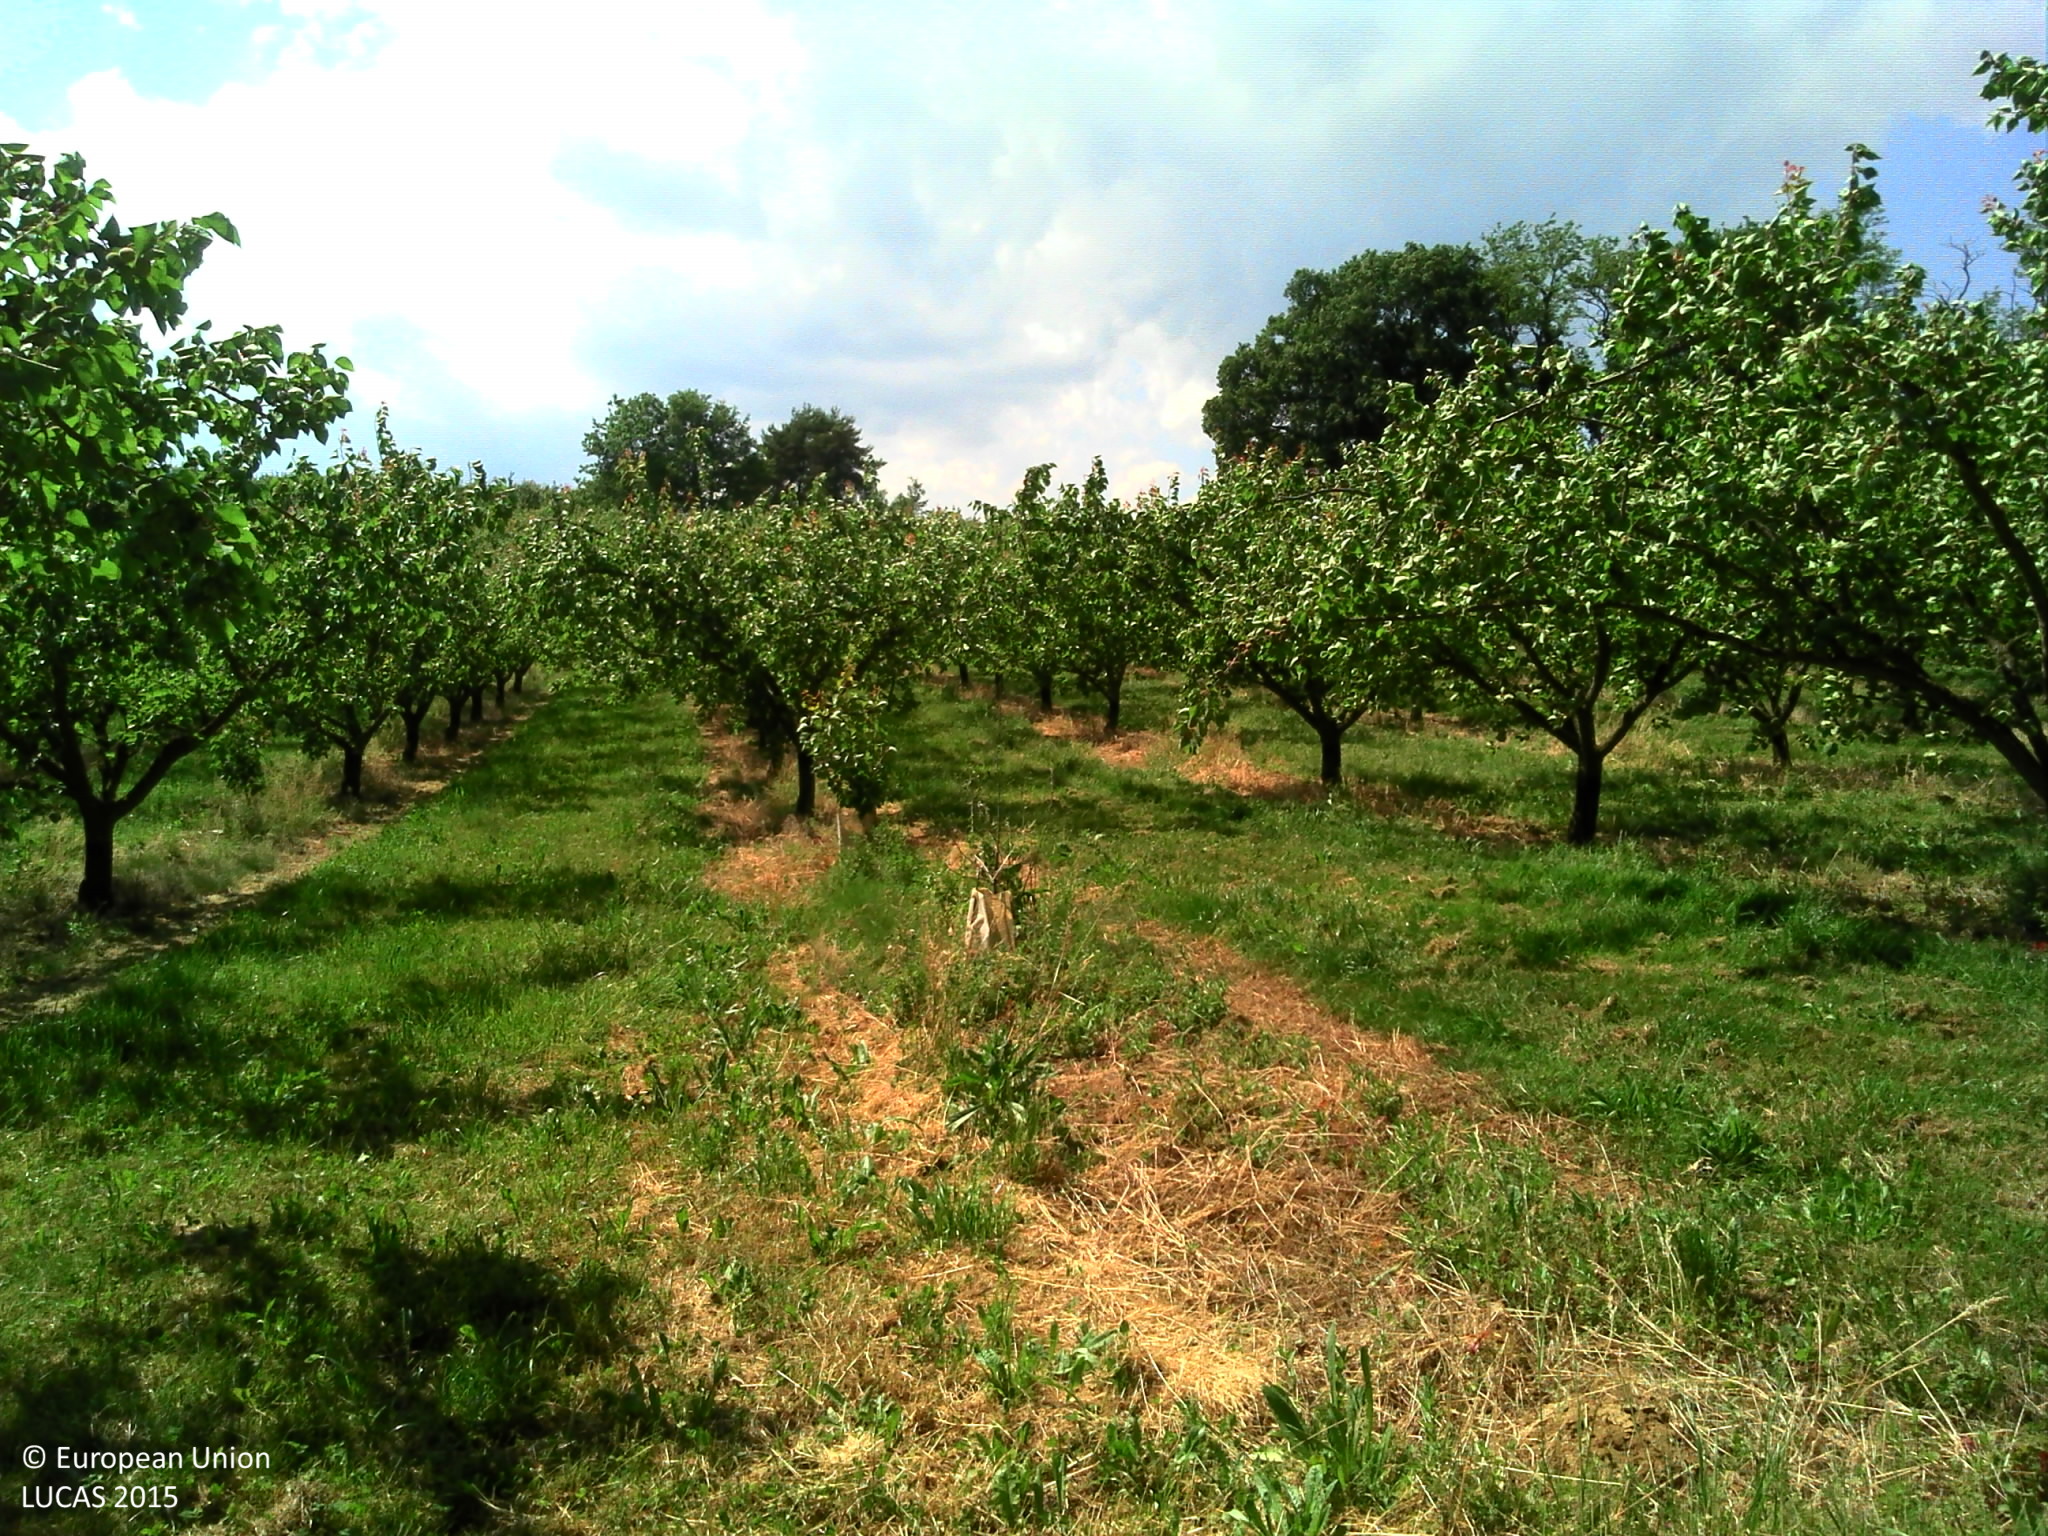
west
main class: Grassland
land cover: Grassland without tree/shrub cover
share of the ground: > 75 %
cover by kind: herbaceous plants 100 %
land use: Agriculture (excluding fallow land and kitchen gardens)
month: May
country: FR
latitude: 45.0748
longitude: 4.9117
